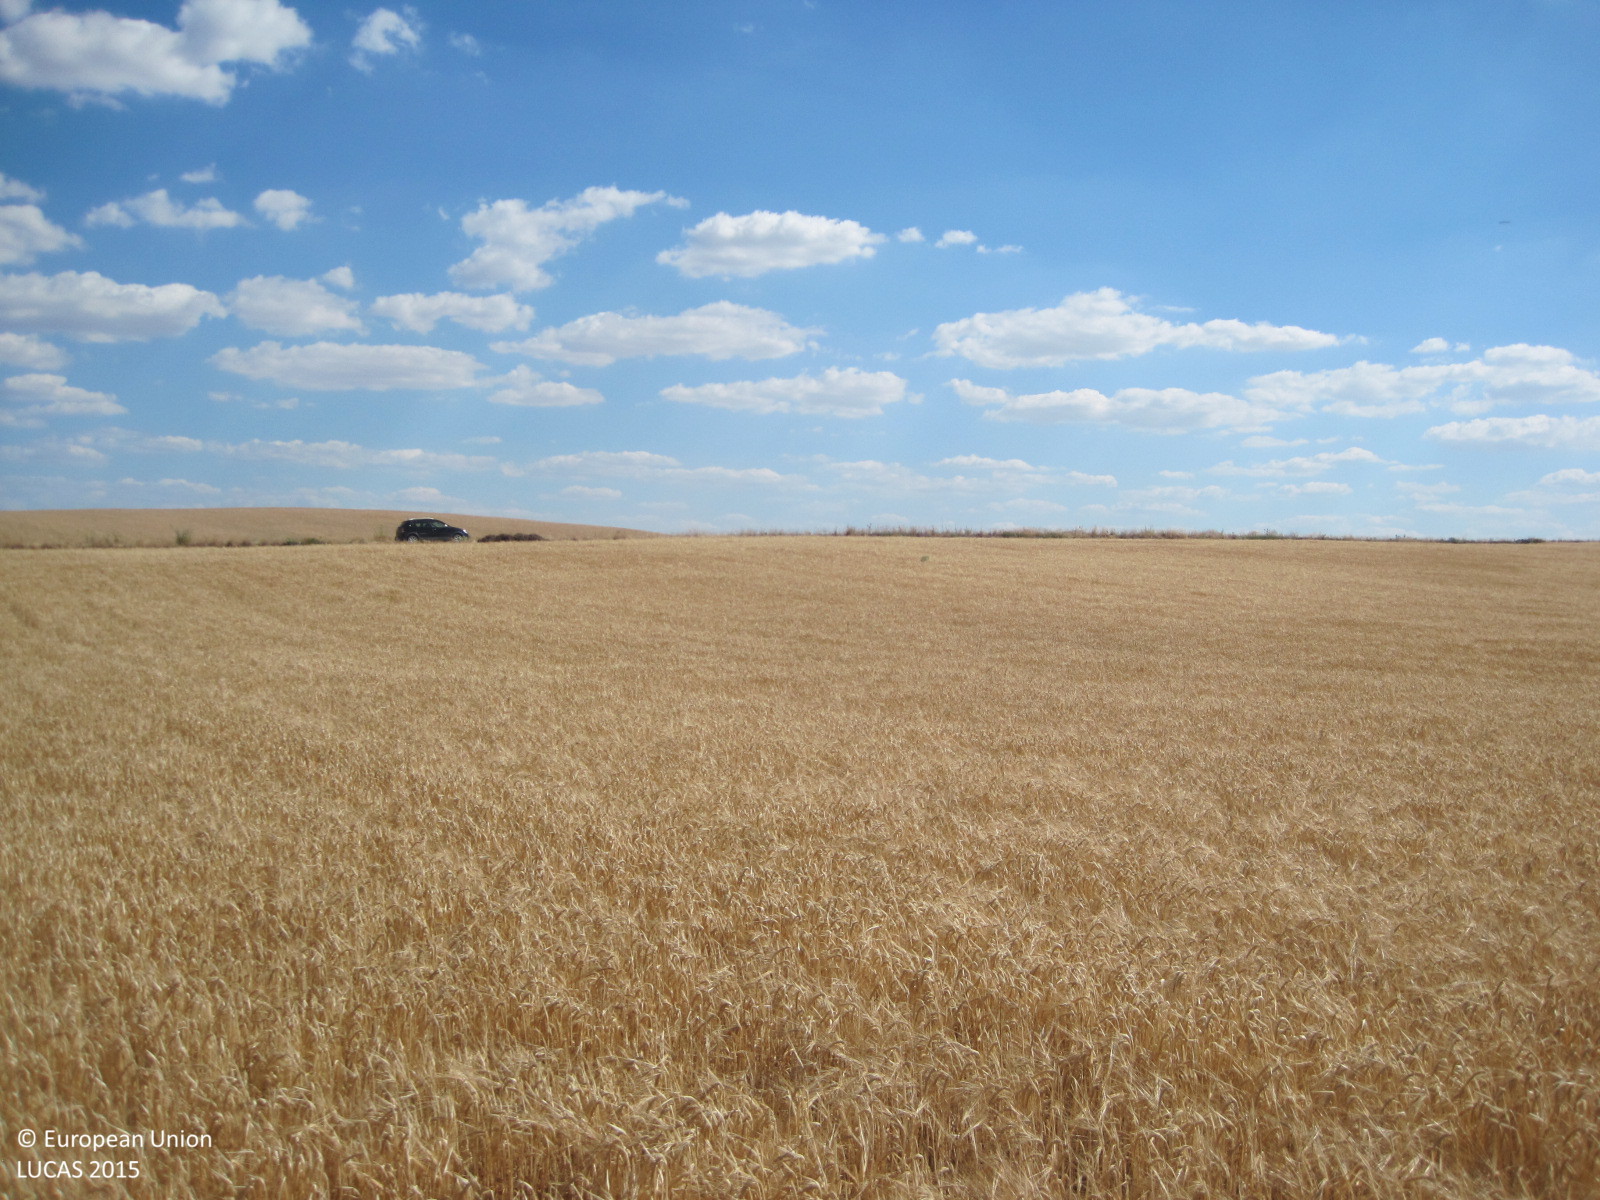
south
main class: Cropland
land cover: Barley
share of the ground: > 75 %
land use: Agriculture (excluding fallow land and kitchen gardens)
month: June
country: ES
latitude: 39.9177
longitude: -4.2530
